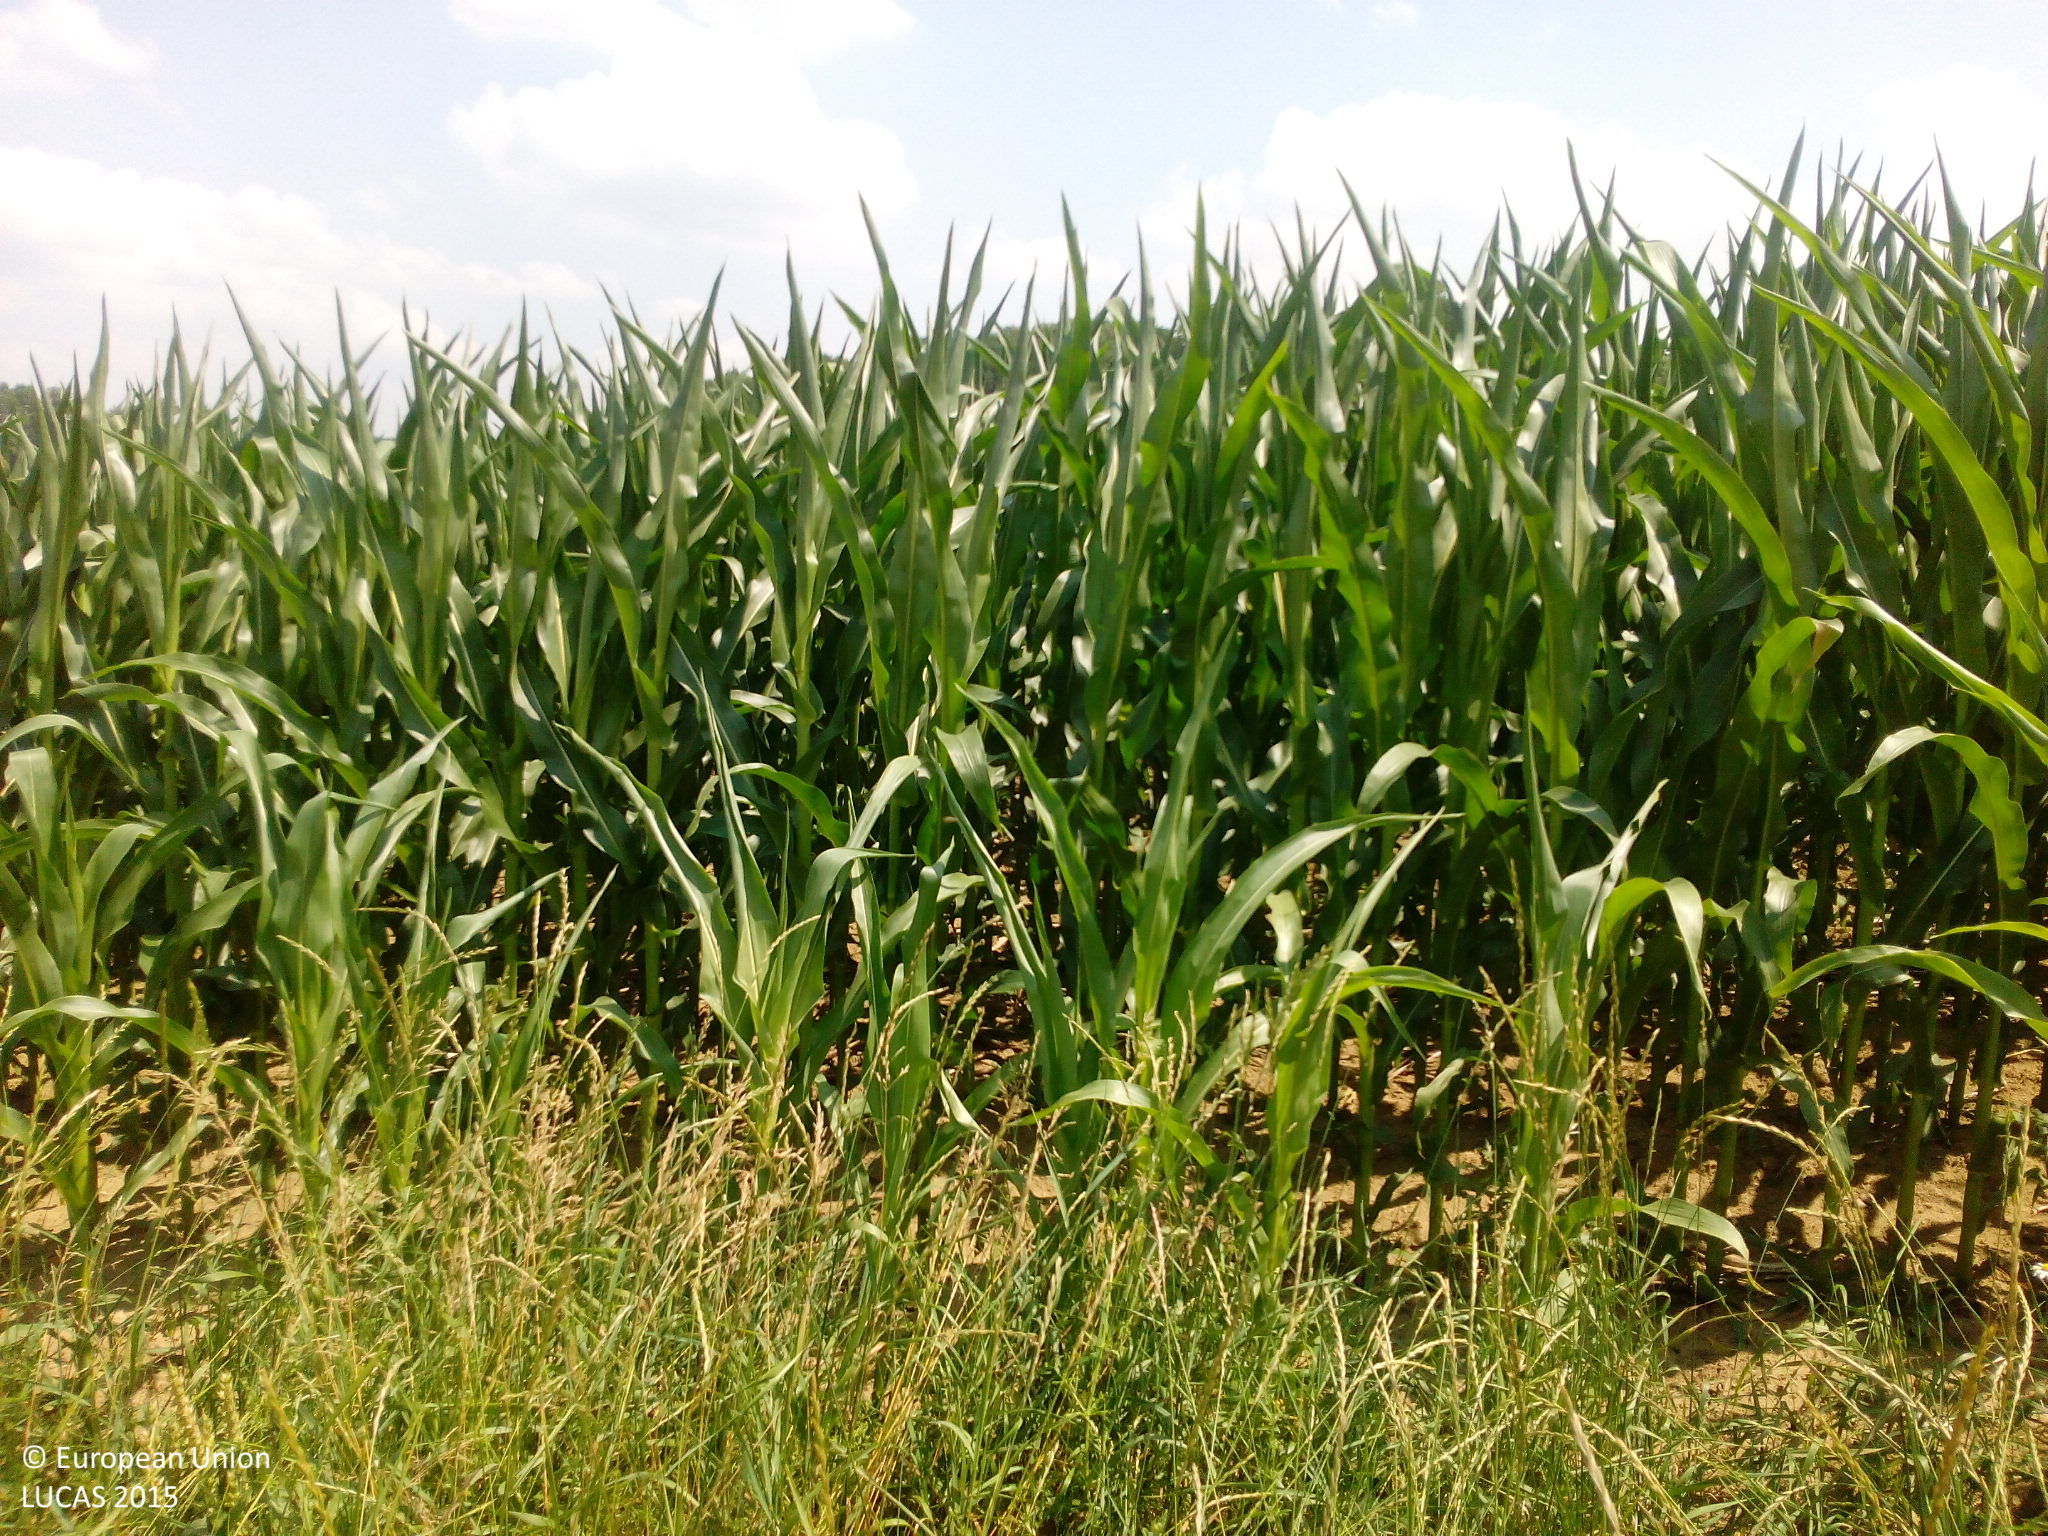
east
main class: Cropland
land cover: Barley
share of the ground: > 75 %
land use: Agriculture (excluding fallow land and kitchen gardens)
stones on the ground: < 10 %
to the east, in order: Barley; Grass margins; Maize; Grassland without tree/shrub cover; Paved roads, cycling and walking lanes; Shruby margins; Lines of trees; Spontaneously vegetated surfaces; Artificial constructions in urban areas; Grassland without tree/shrub cover
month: July
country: DE
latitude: 48.7648
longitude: 11.9176
